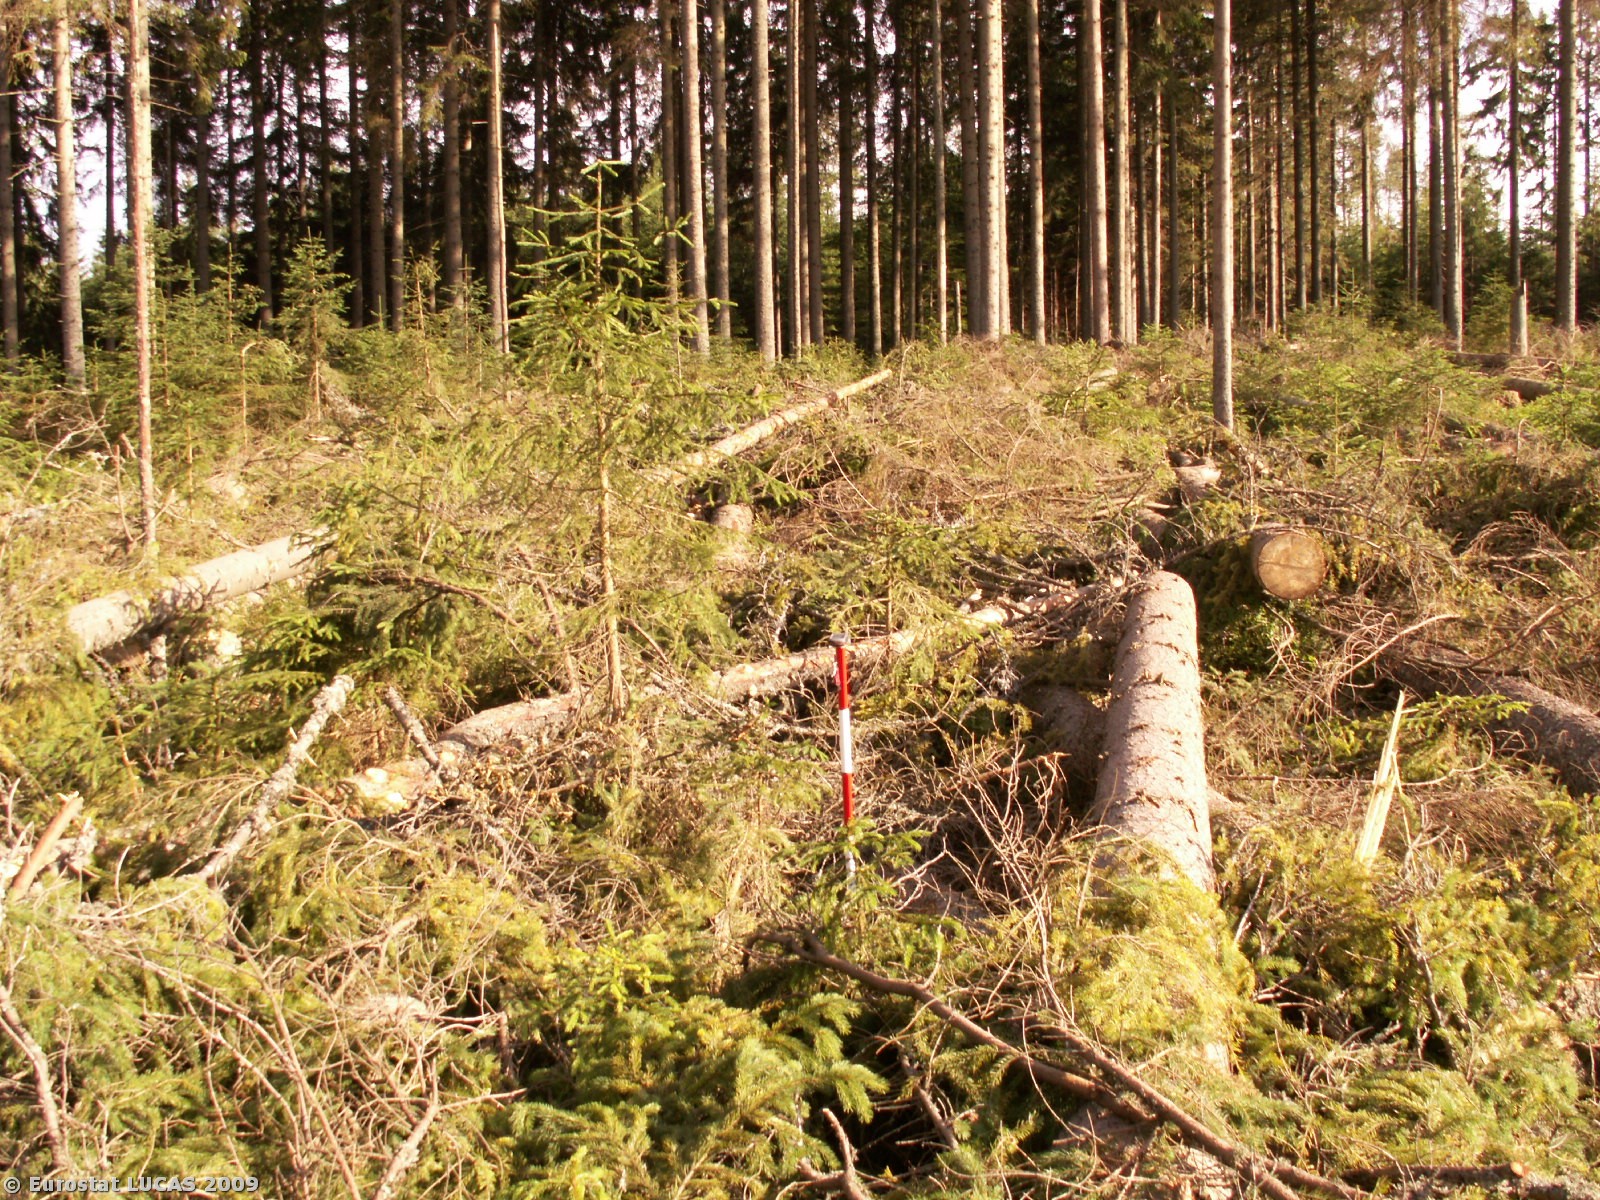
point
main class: Woodland
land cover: Coniferous woodland
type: hemiboreal forest and nemoral coniferous forest and mixed broadleaved-coniferous forest
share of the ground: > 75 %
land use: Forestry
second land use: Nature reserves
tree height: > 5 m
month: July
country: CZ
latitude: 48.8056
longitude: 13.8261
